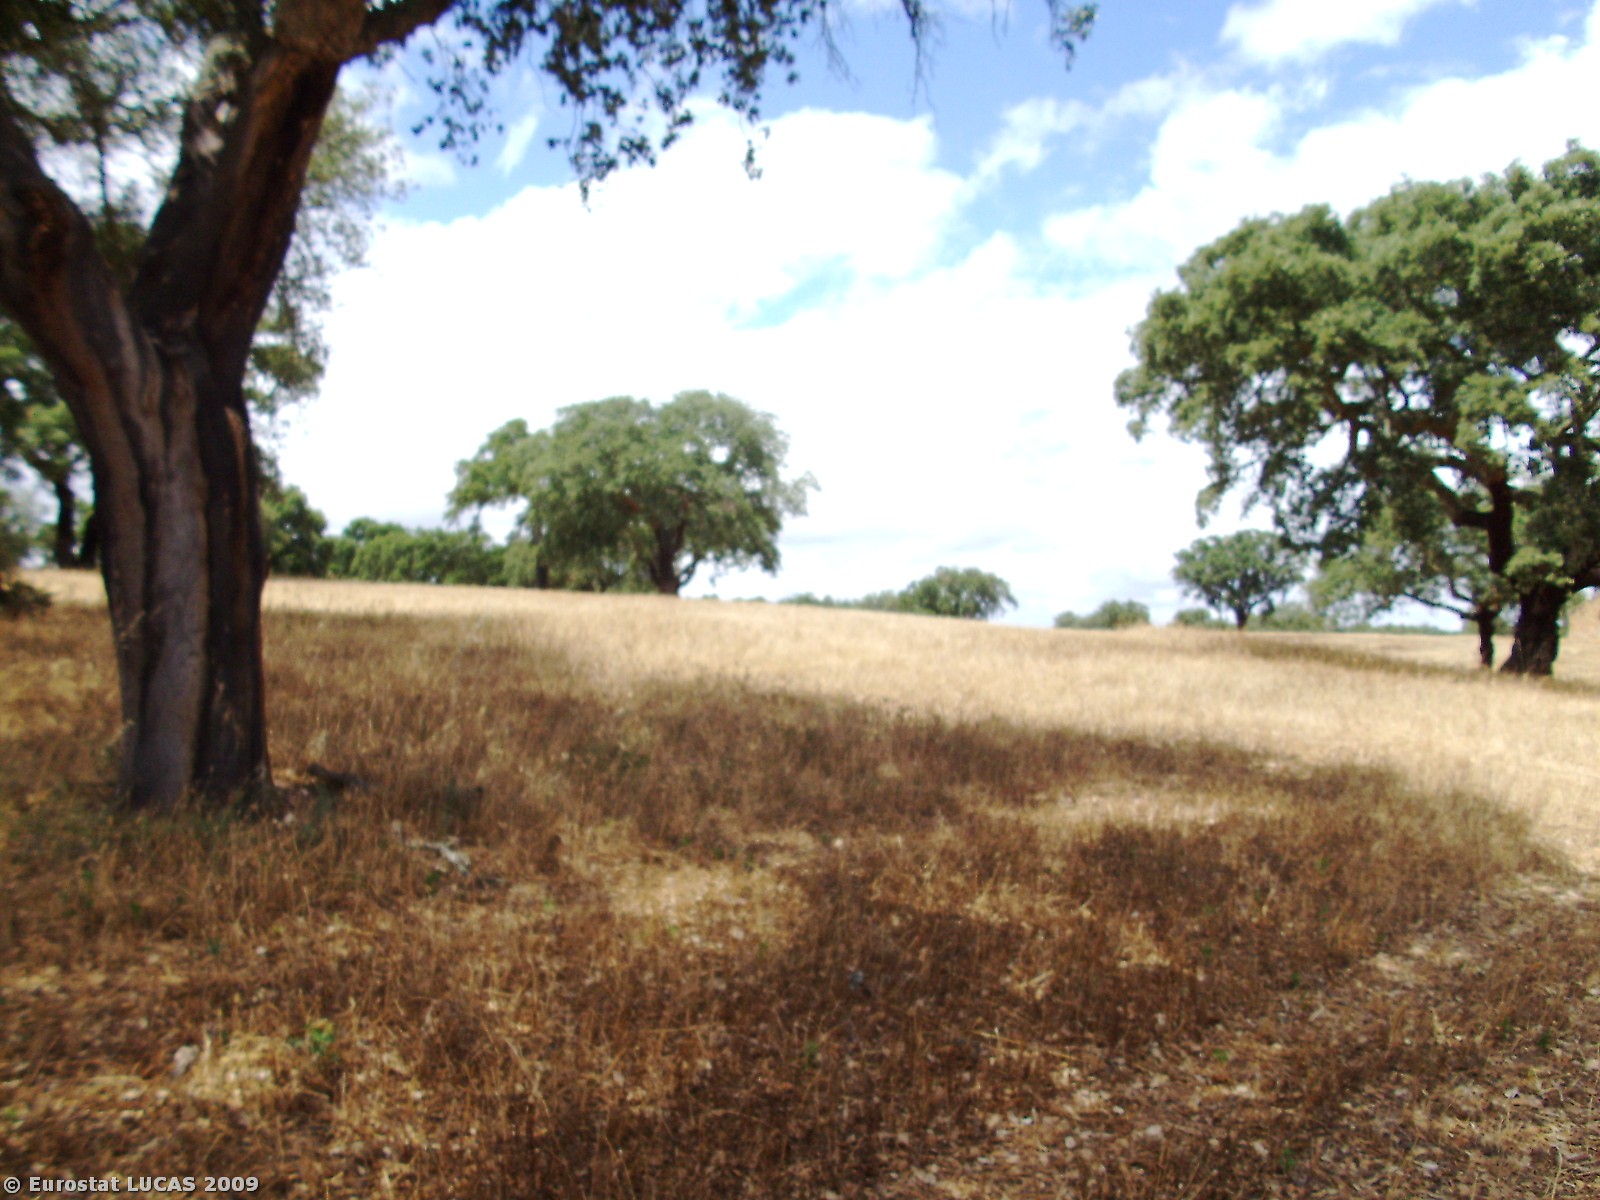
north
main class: Woodland
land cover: Broadleaved woodland
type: broadleaved evergreen forest
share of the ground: 10 - 25 %
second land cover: Spontaneously vegetated surfaces
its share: 50 - 75 %
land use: Forestry
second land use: Fallow land
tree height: > 5 m
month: June
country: PT
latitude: 37.8237
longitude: -8.4074
